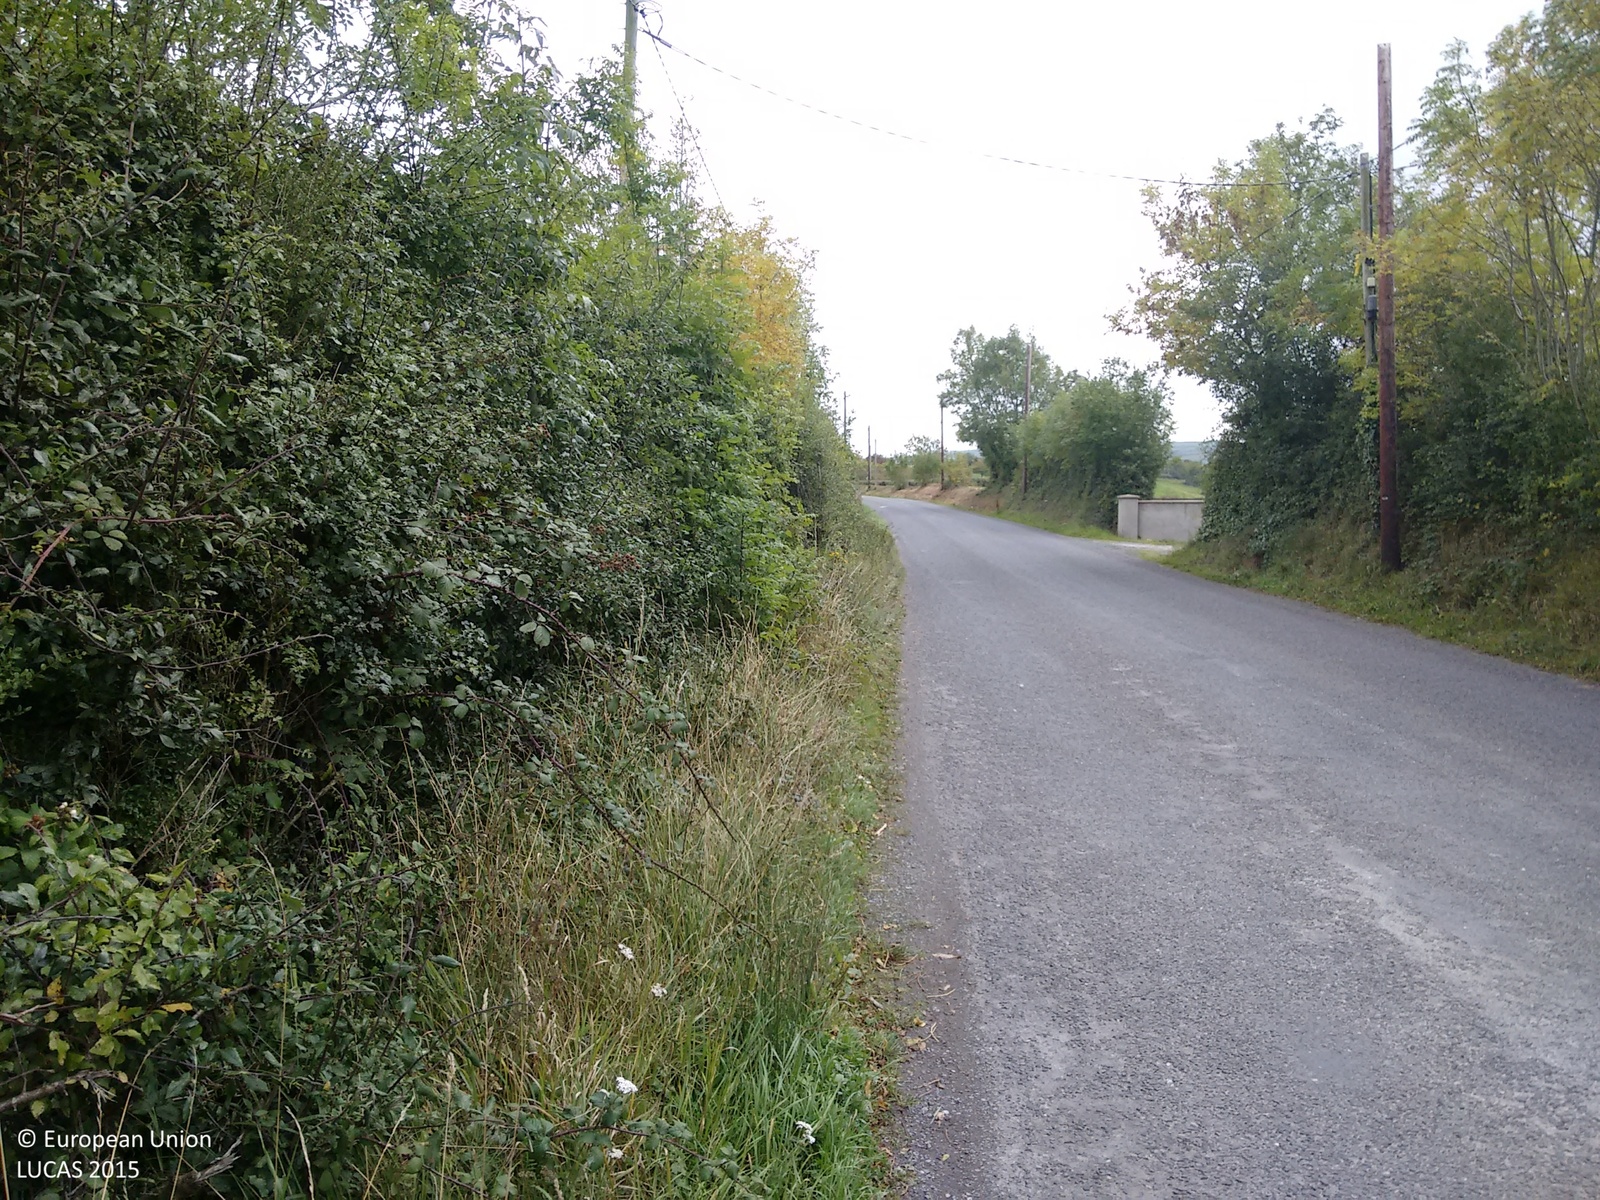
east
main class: Grassland
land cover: Grassland without tree/shrub cover
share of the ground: > 75 %
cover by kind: herbaceous plants 85 %
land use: Agriculture (excluding fallow land and kitchen gardens)
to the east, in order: Grassland without tree/shrub cover; Abandoned hedges; Grassland without tree/shrub cover; Abandoned hedges; Grassland without tree/shrub cover; Managed hedges; Ditches and canals; Fences; Grassland without tree/shrub cover
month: September
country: IE
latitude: 52.3758
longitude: -9.0008
